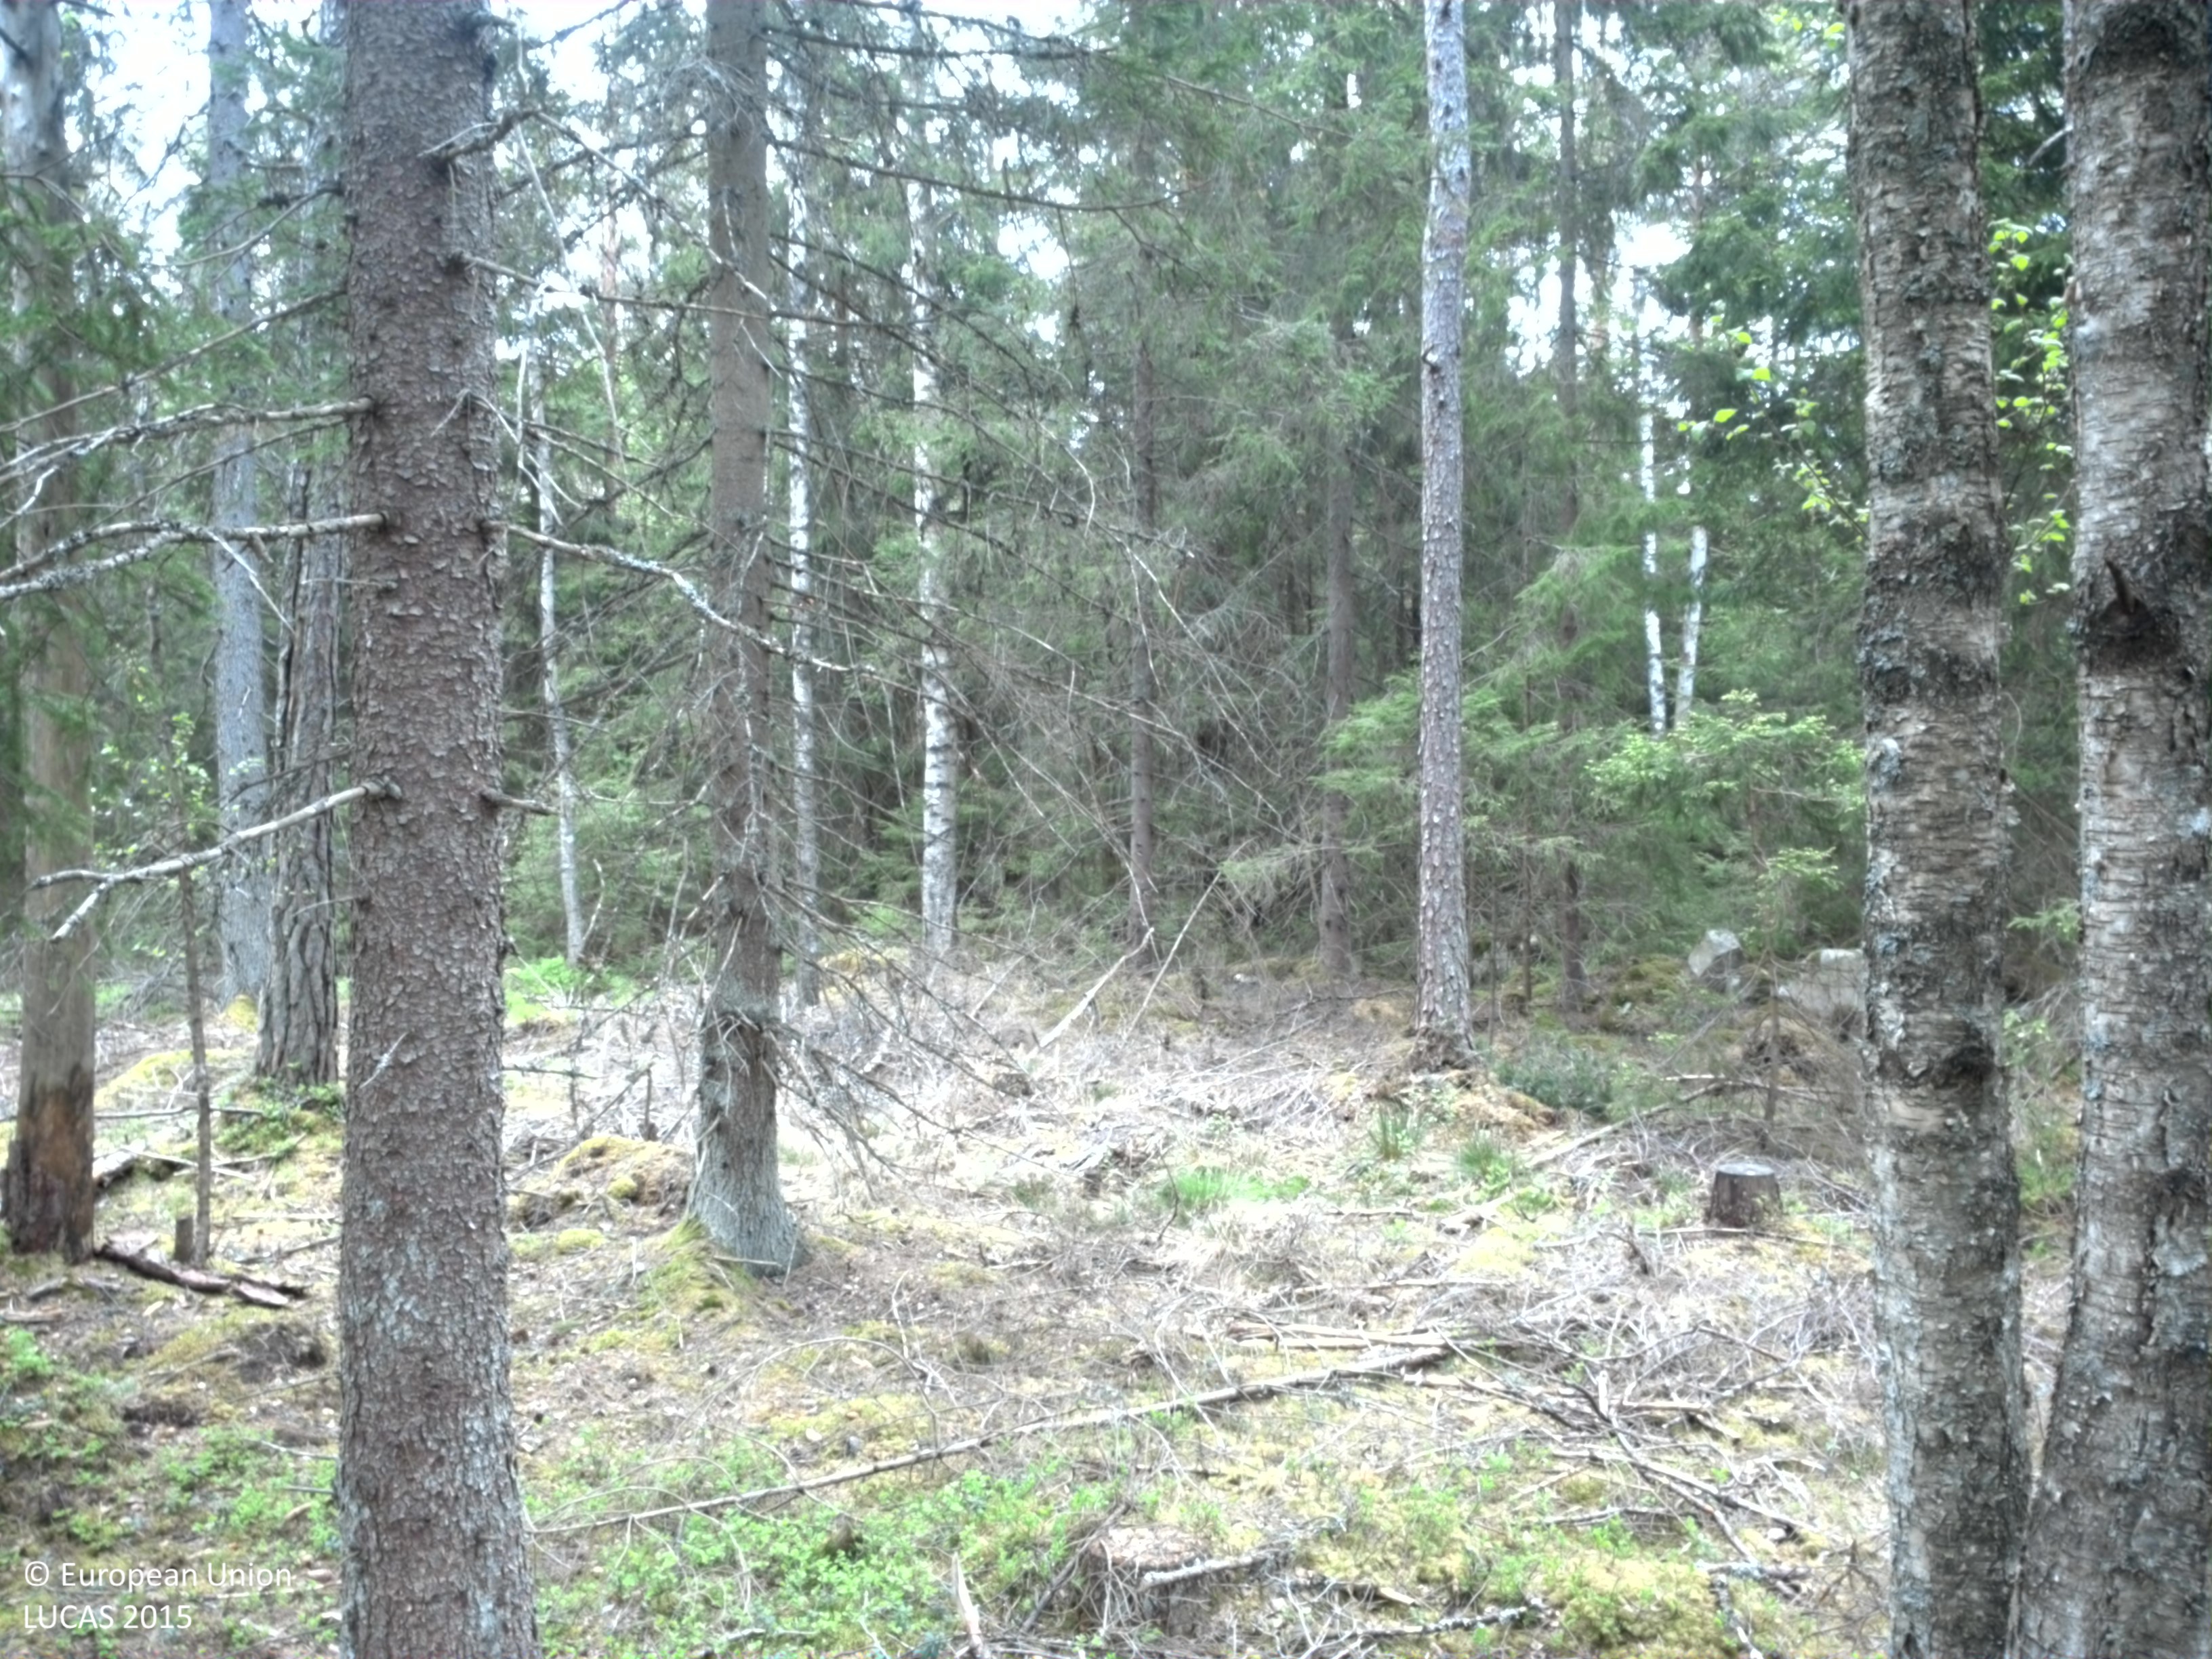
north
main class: Woodland
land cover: Spruce dominated coniferous woodland
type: boreal forest
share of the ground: > 75 %
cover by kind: coniferous forest trees 70 %, lichens and mosses 20 %, broadleaved forest trees 10 %
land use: Forestry
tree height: > 5 m
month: May
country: SE
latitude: 56.9470
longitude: 15.2088
